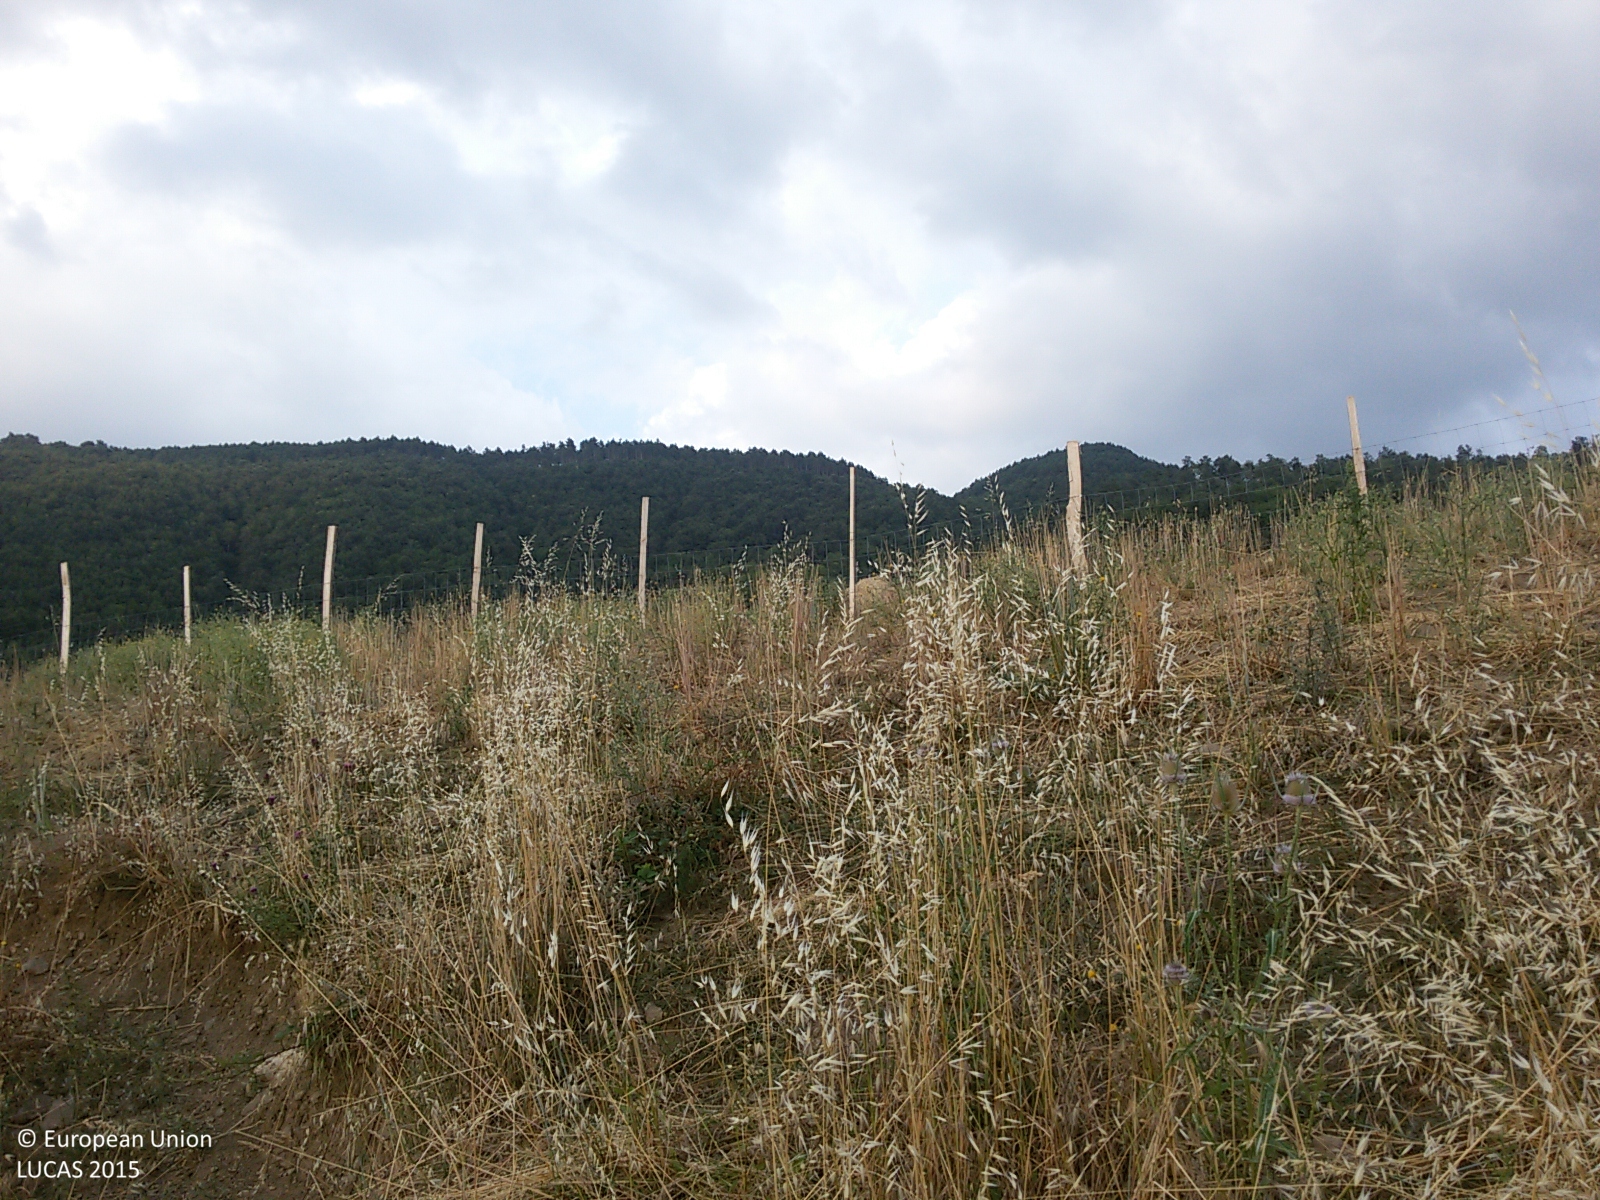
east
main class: Cropland
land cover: Temporary grasslands
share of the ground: > 75 %
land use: Agriculture (excluding fallow land and kitchen gardens)
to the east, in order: Temporary grasslands; Oats; Fences; Abandoned hedges; Paved roads, cycling and walking lanes; Grass margins; Ditches and canals; Abandoned hedges; Fences; Temporary grasslands
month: July
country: IT
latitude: 42.8604
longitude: 11.4518
